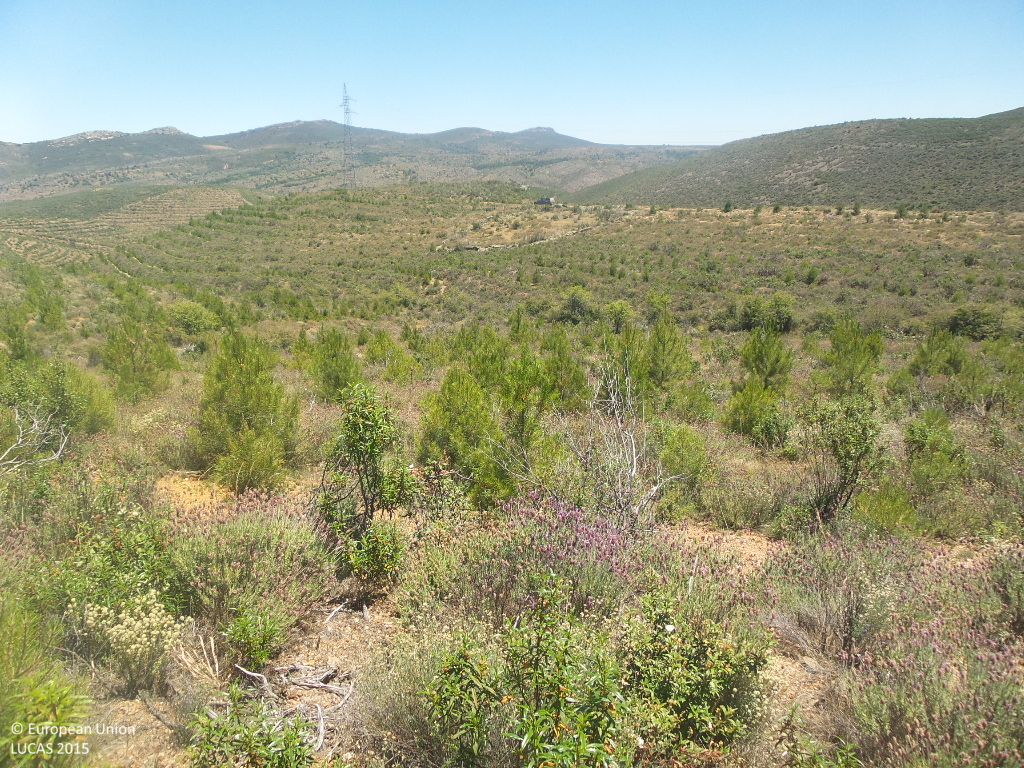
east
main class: Woodland
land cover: Pine dominated coniferous woodland
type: coniferous forest of the mediterranean region
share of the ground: 10 - 25 %
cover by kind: shrubs 60 %, coniferous forest trees 20 %, unconsolidated bare surface 20 %
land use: Forestry
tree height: < 5 m
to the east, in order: Pine dominated coniferous woodland; Shrubland without tree cover; Pine dominated coniferous woodland; Shrubland without tree cover; Dry stone walls; Shrubland without tree cover; Dry stone walls; Tracks; Shrubland without tree cover; Electric lines; Shrubland without tree cover
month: June
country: ES
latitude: 41.1440
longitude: -2.9401
